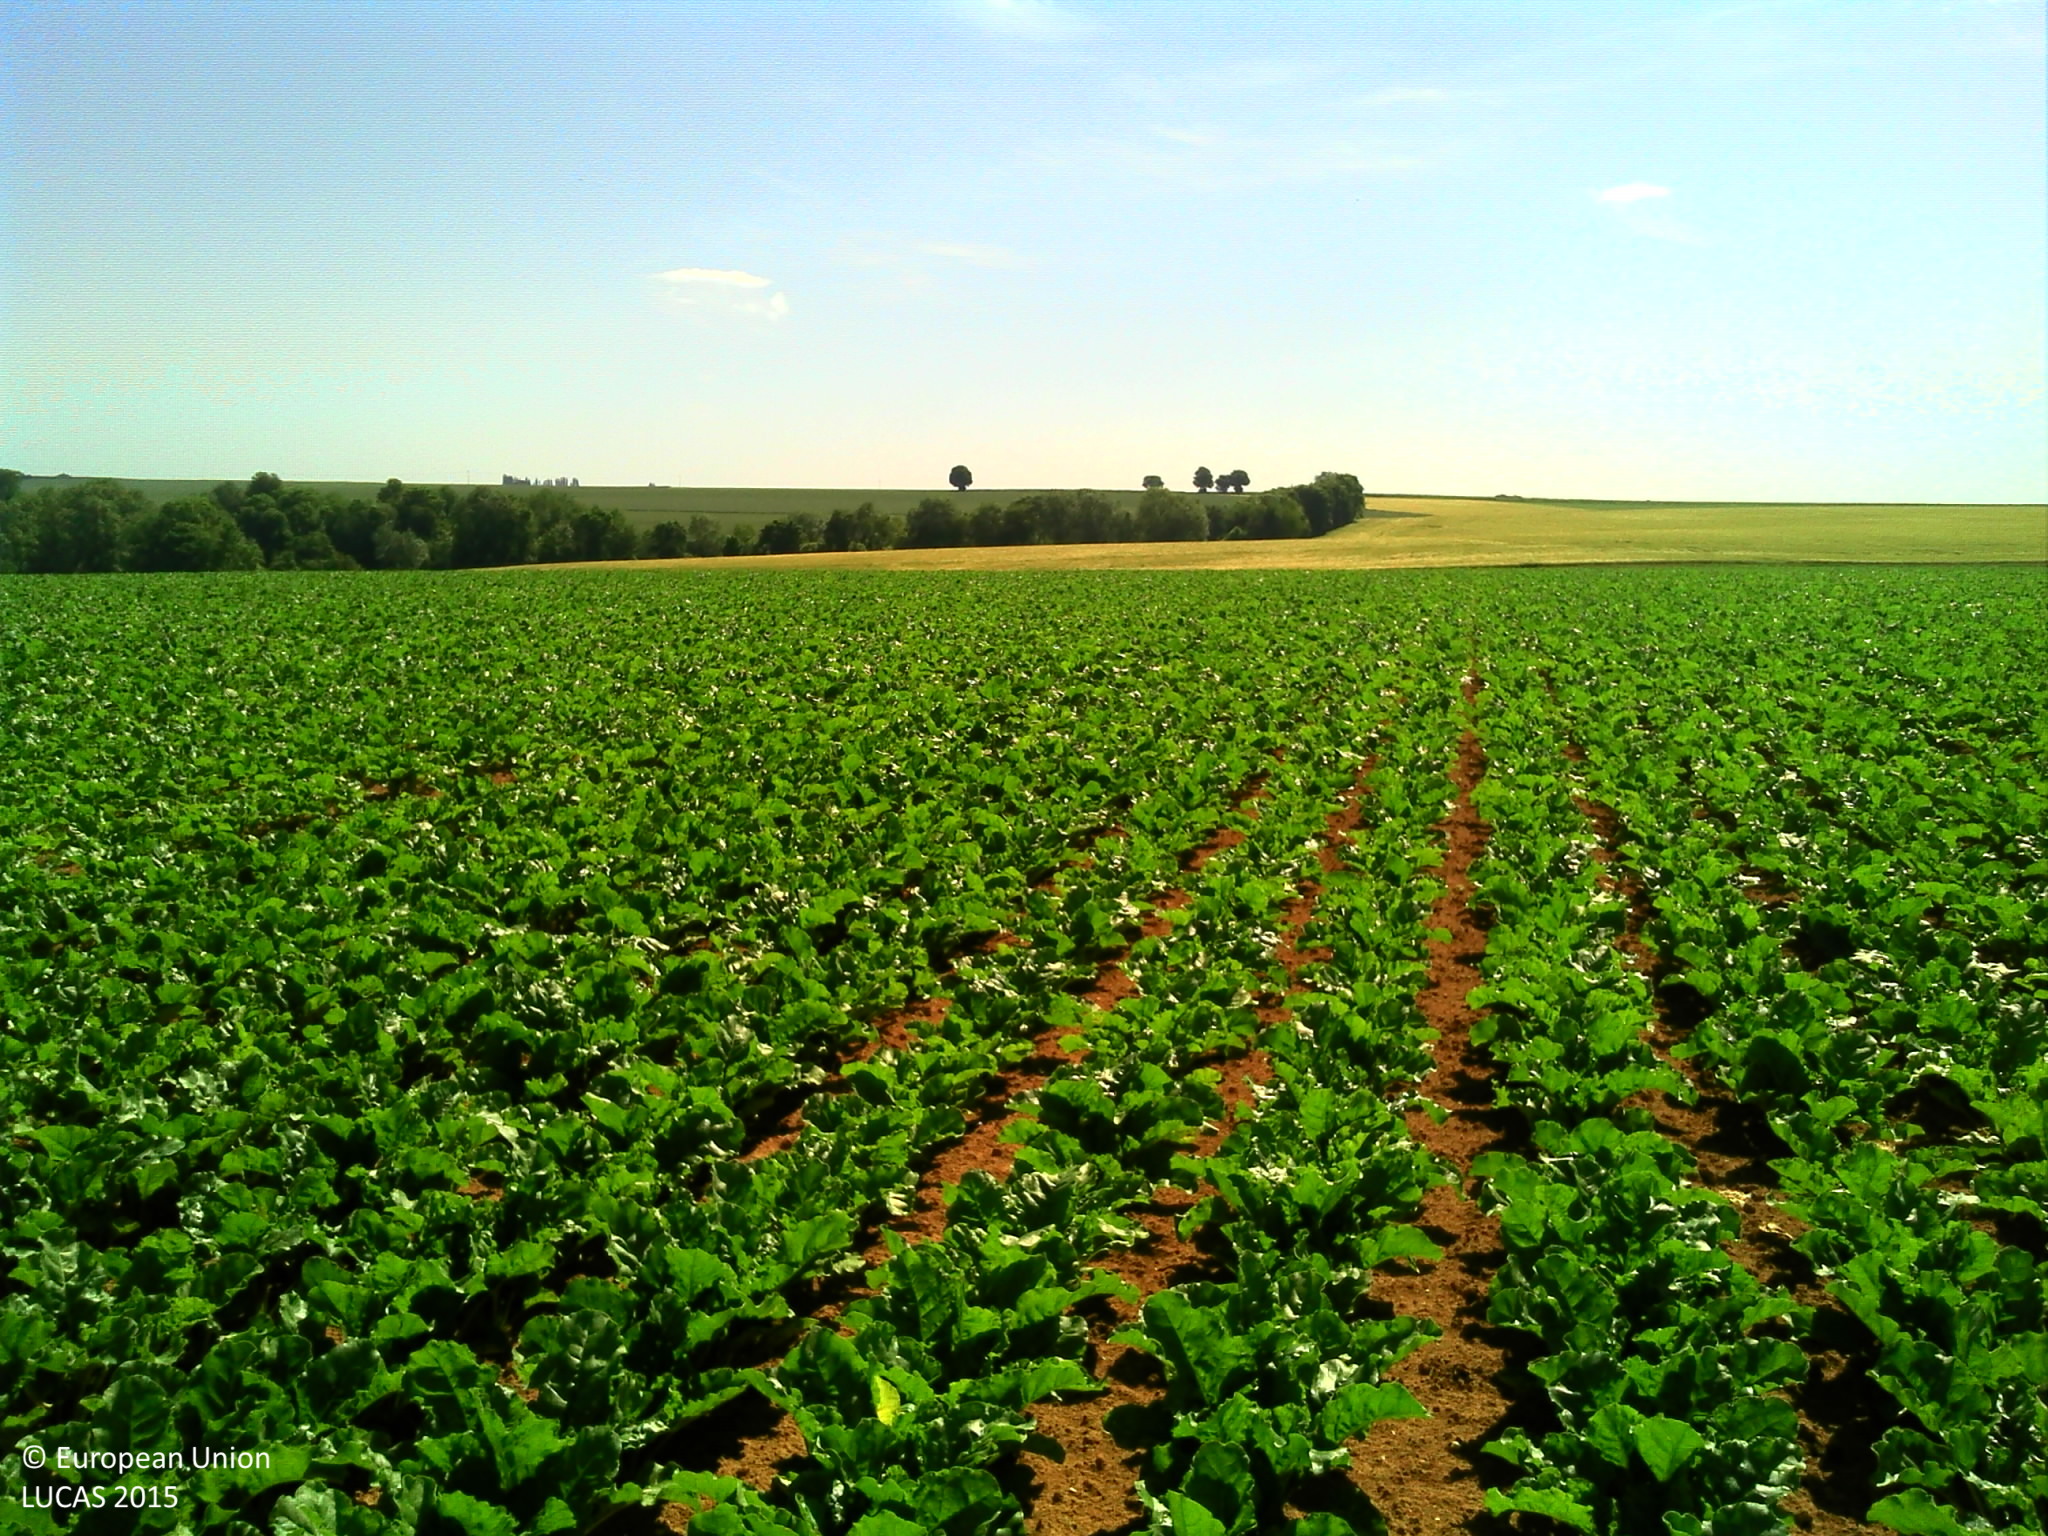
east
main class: Cropland
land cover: Sugar beet
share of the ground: > 75 %
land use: Agriculture (excluding fallow land and kitchen gardens)
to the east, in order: Sugar beet
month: June
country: FR
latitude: 49.4442
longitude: 3.2751
